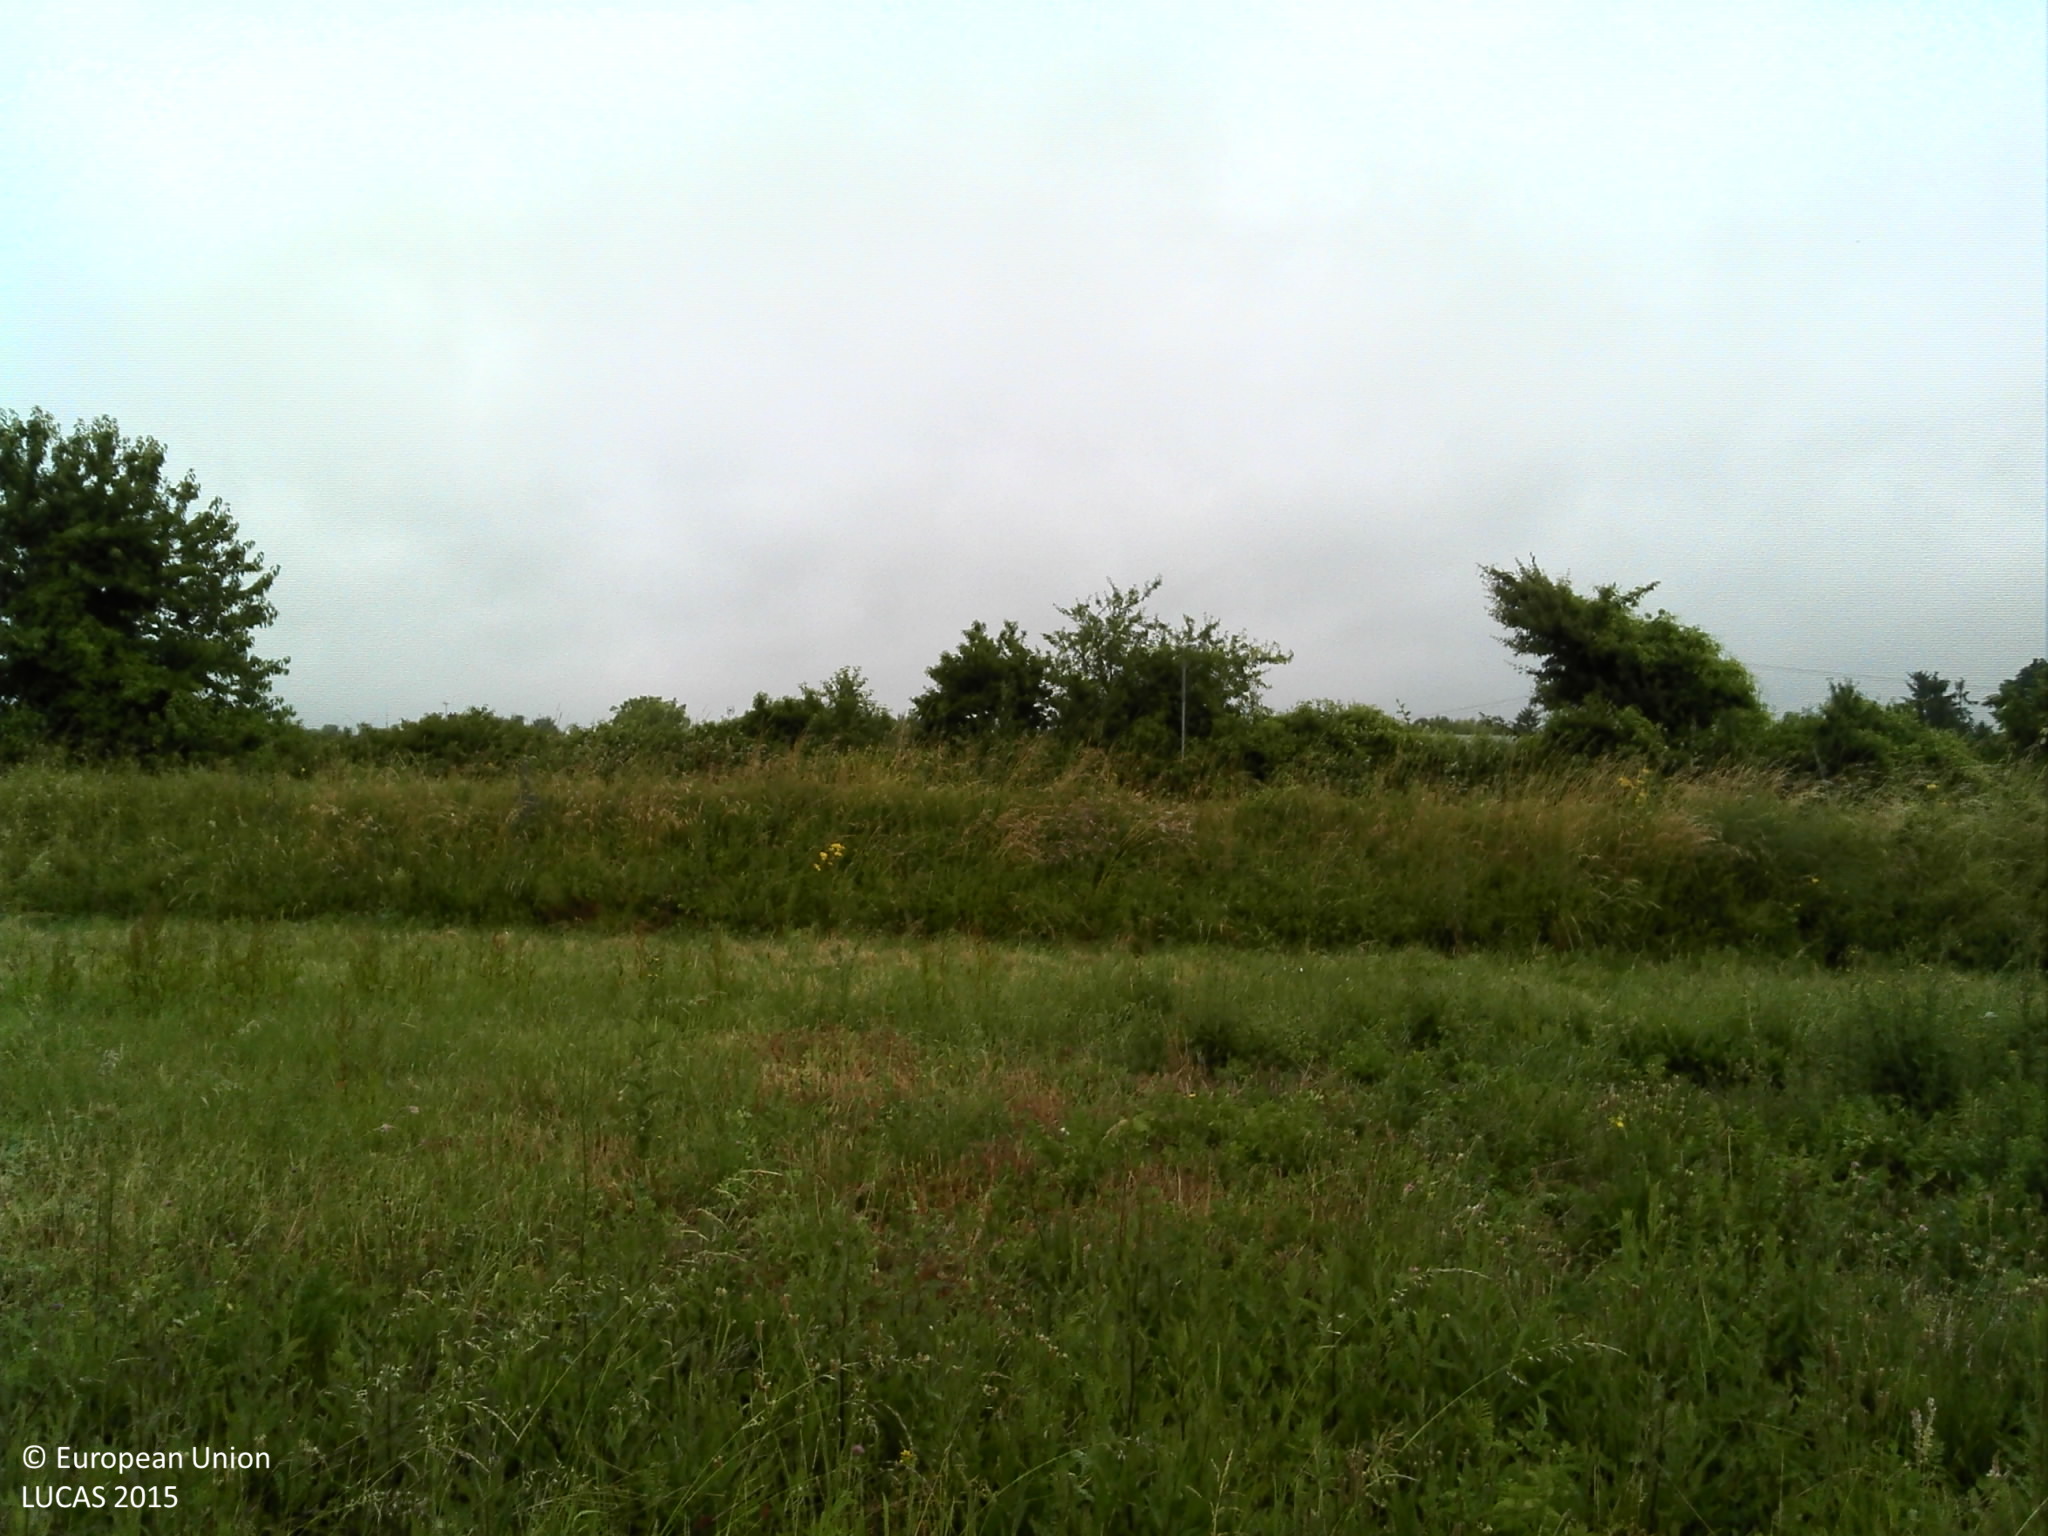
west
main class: Grassland
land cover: Spontaneously vegetated surfaces
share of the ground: > 75 %
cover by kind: herbaceous plants 80 %, lichens and mosses 10 %, consolidated bare surface 10 %
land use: Semi-natural and natural areas not in use
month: June
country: FR
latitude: 48.6660
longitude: 4.1983
